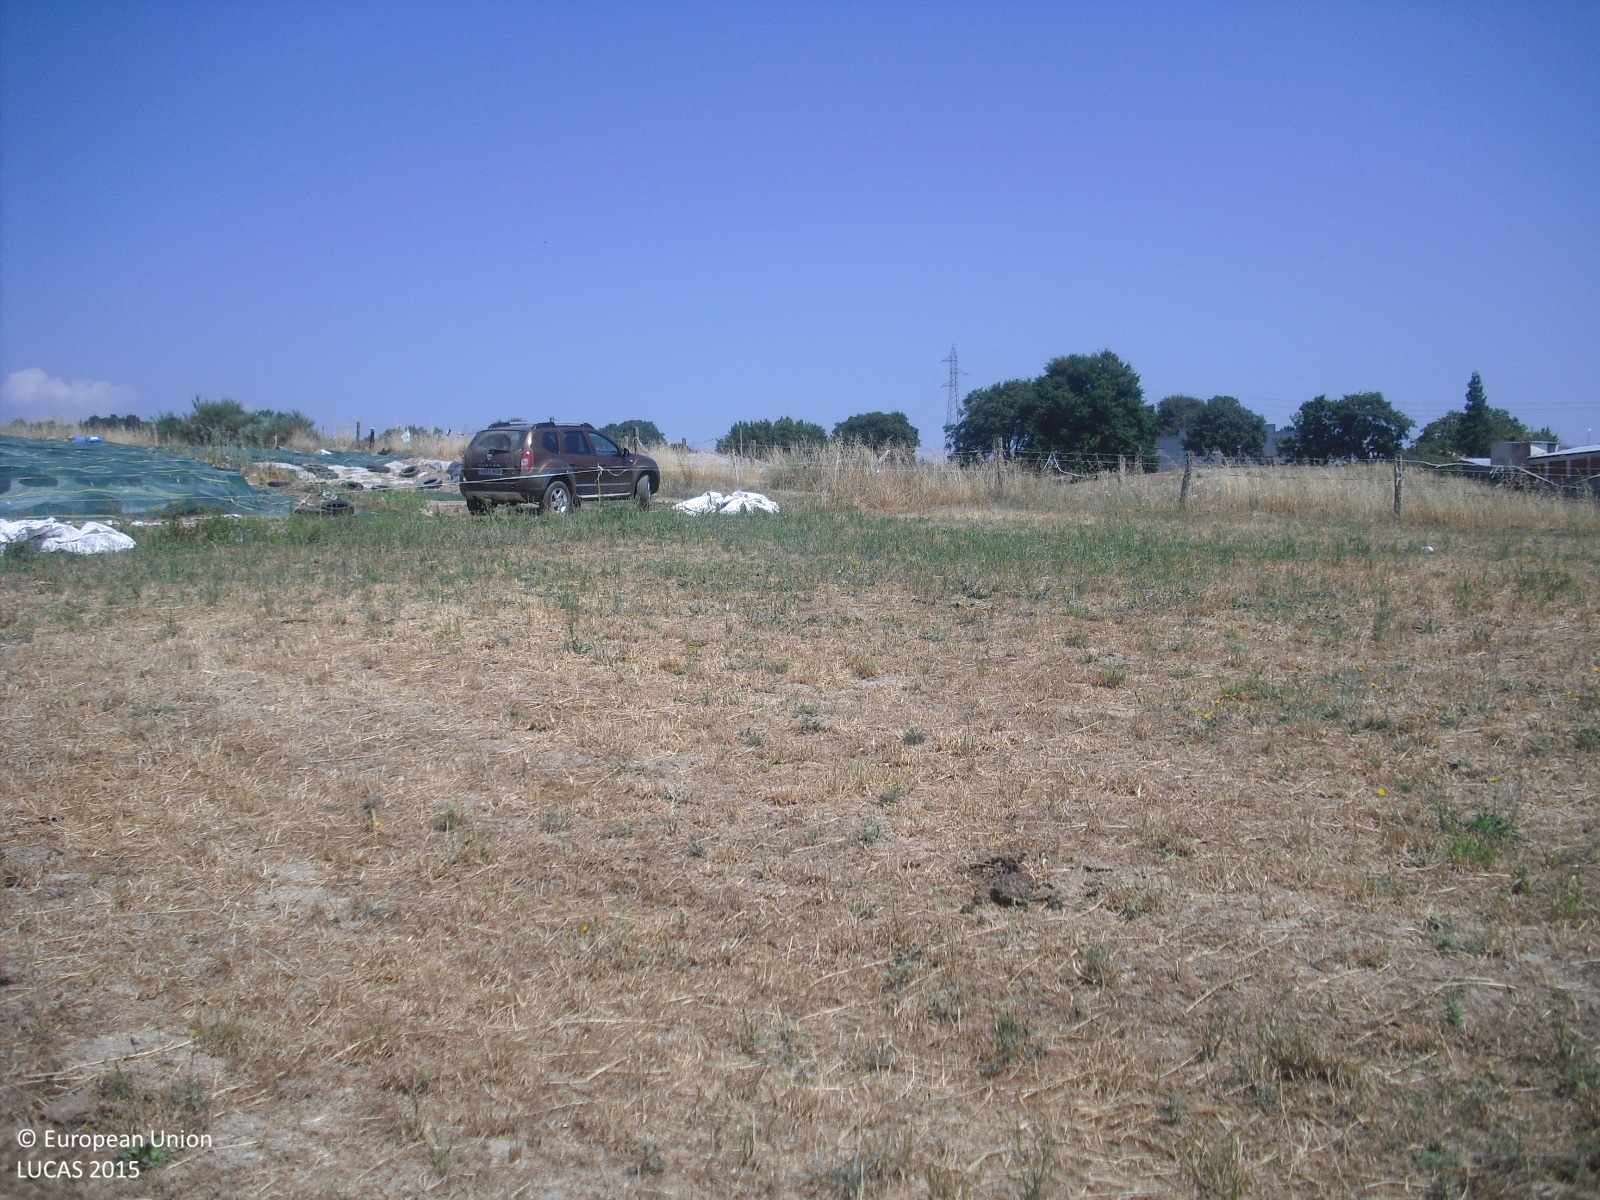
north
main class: Cropland
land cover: Temporary grasslands
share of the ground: > 75 %
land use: Agriculture (excluding fallow land and kitchen gardens)
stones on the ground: 25 - 50 %
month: June
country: ES
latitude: 42.6176
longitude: -7.7678
